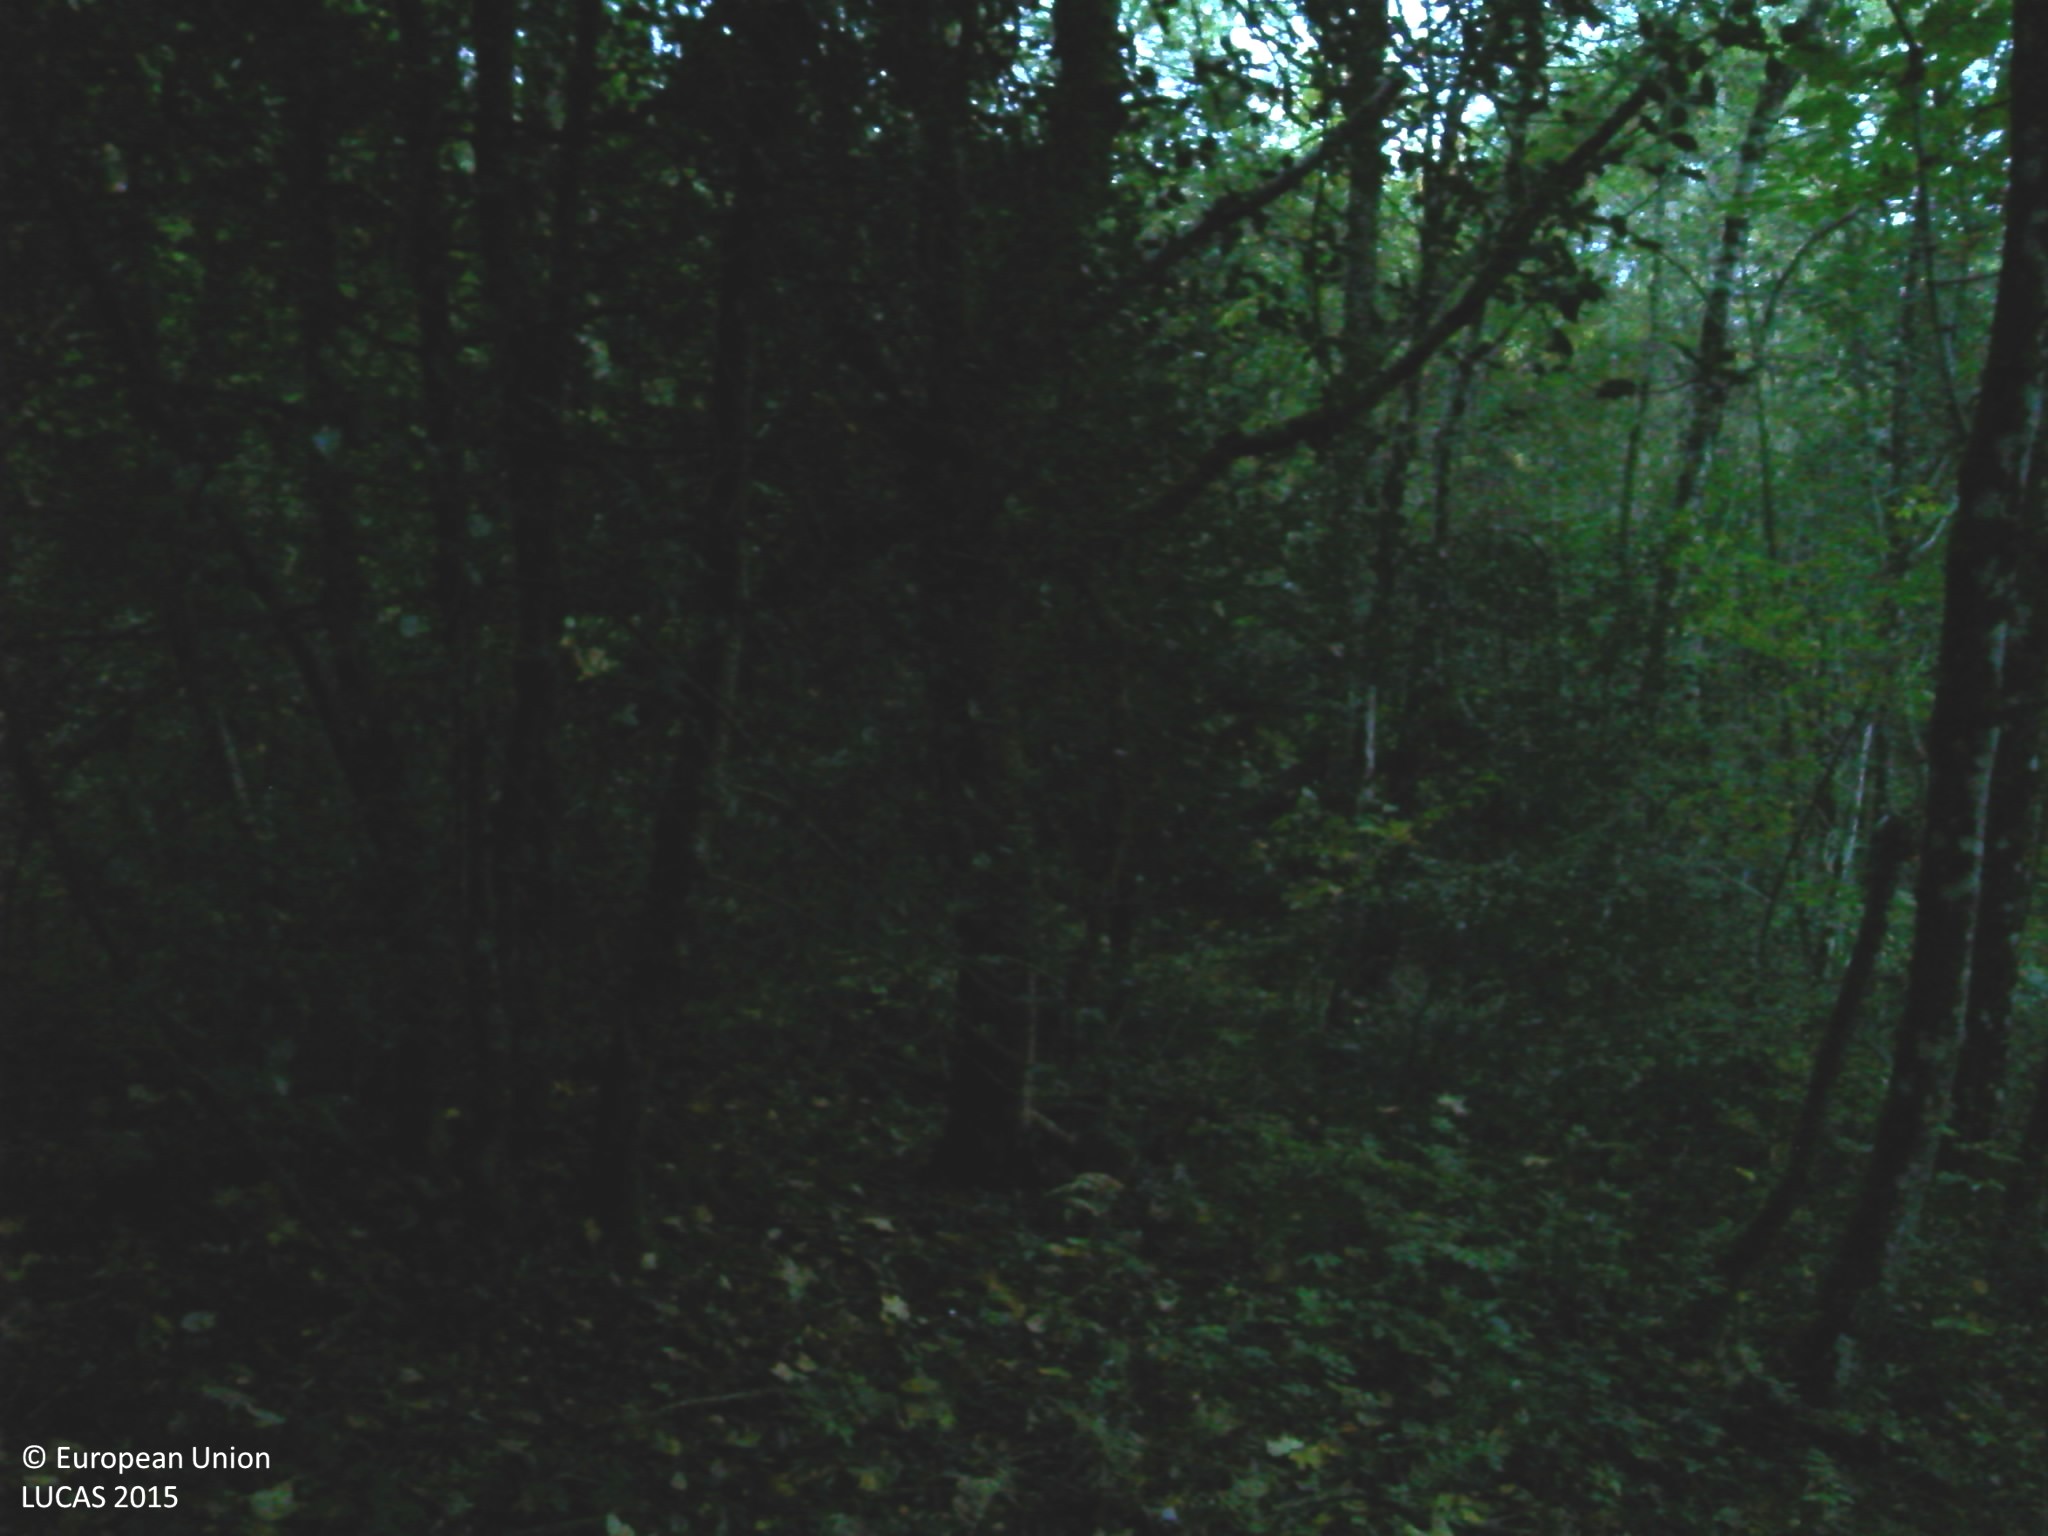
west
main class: Woodland
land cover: Broadleaved woodland
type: mesophytic deciduous forest
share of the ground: > 75 %
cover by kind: broadleaved forest trees 85 %, shrubs 10 %, herbaceous plants 5 %
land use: Forestry
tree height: > 5 m
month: October
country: FR
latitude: 45.8211
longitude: 3.6816
